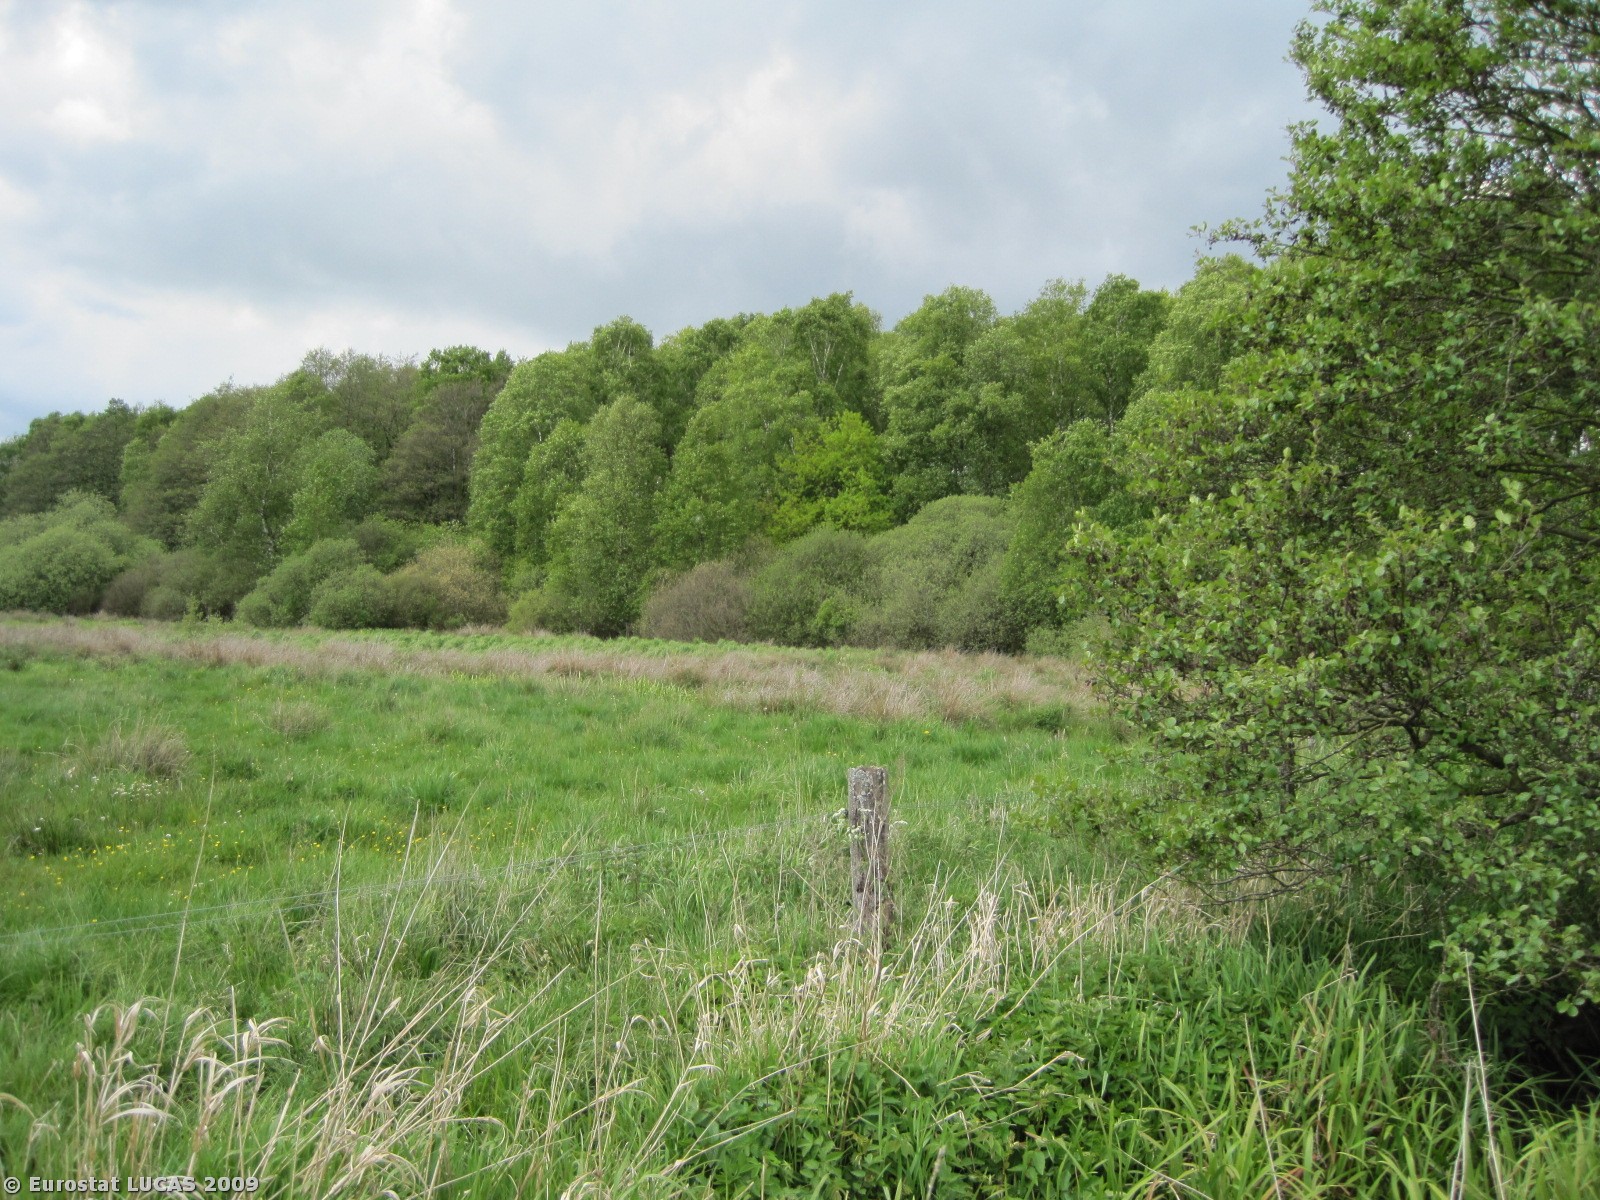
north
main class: Wetlands
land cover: Inland marshes
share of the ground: > 75 %
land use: Unused
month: May
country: DK
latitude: 56.3852
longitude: 9.7250
